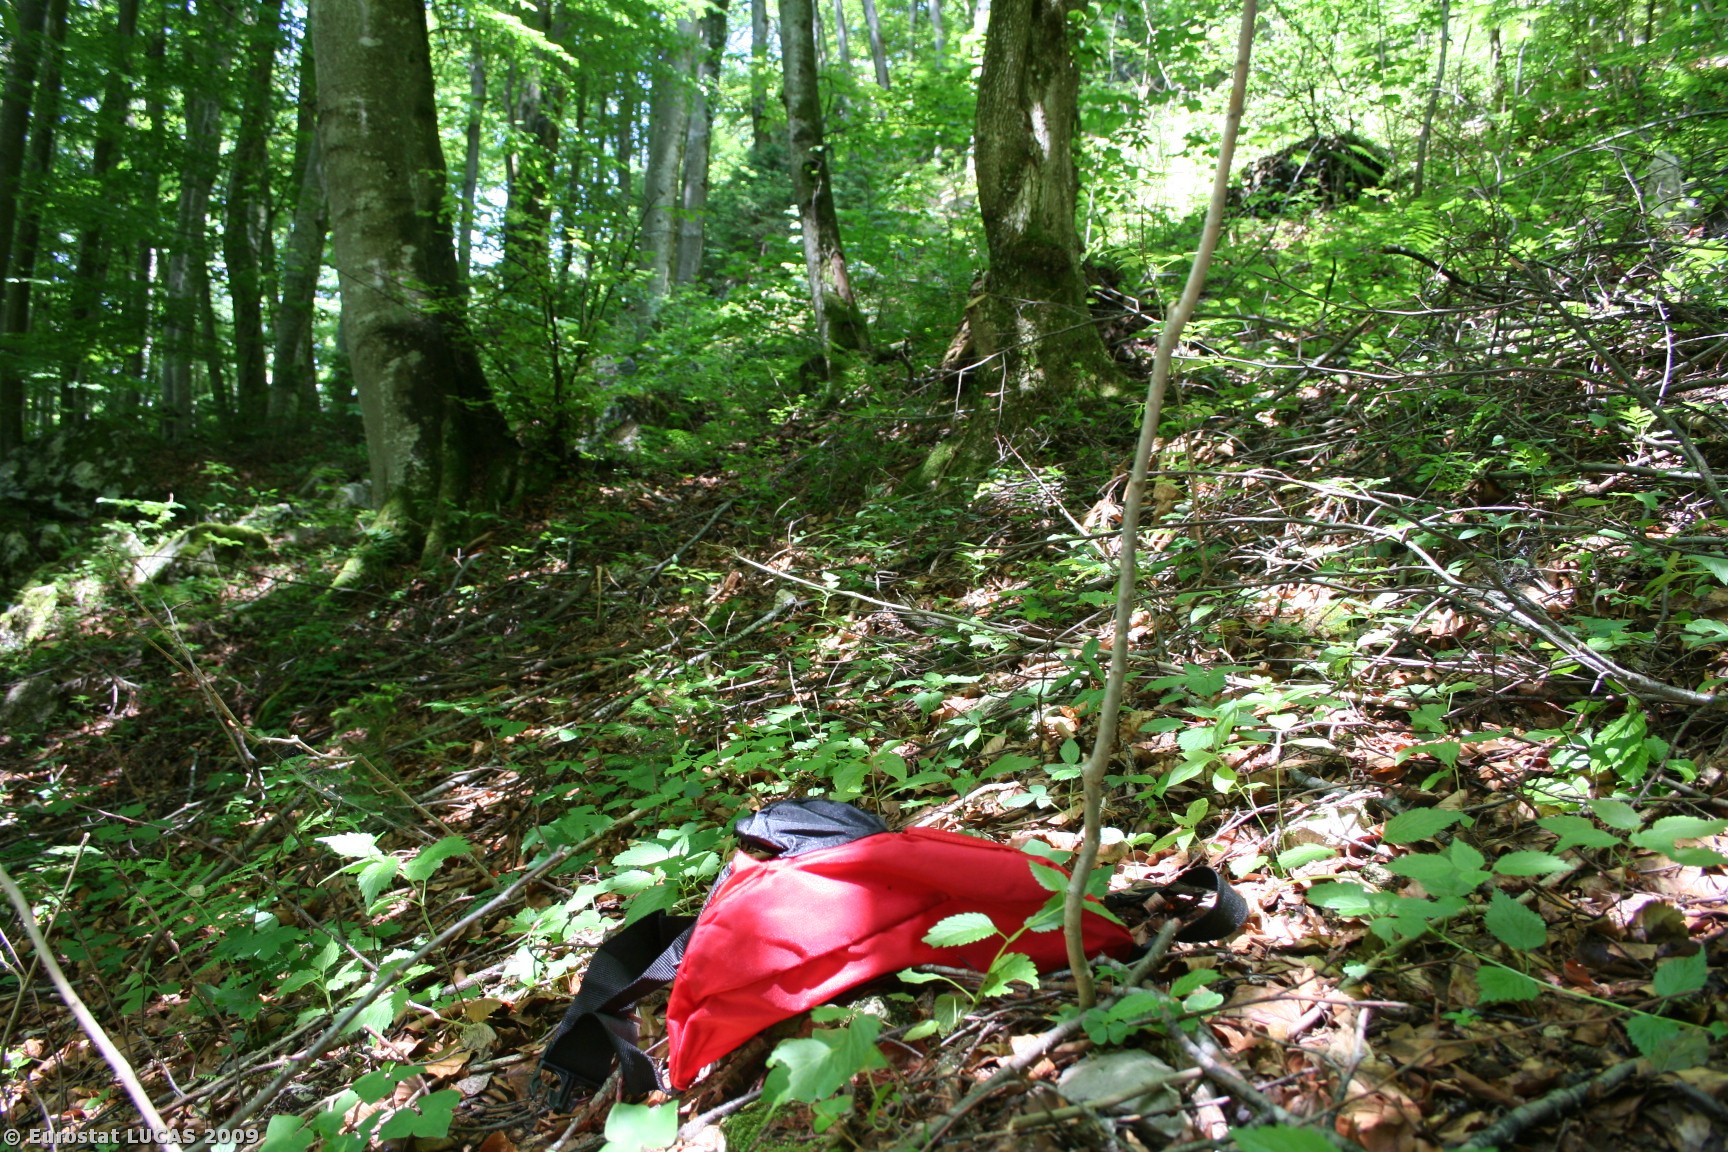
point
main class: Woodland
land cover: Mixed woodland
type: hemiboreal forest and nemoral coniferous forest and mixed broadleaved-coniferous forest
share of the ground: > 75 %
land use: Forestry
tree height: > 5 m
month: May
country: AT
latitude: 47.6007
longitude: 13.2039
